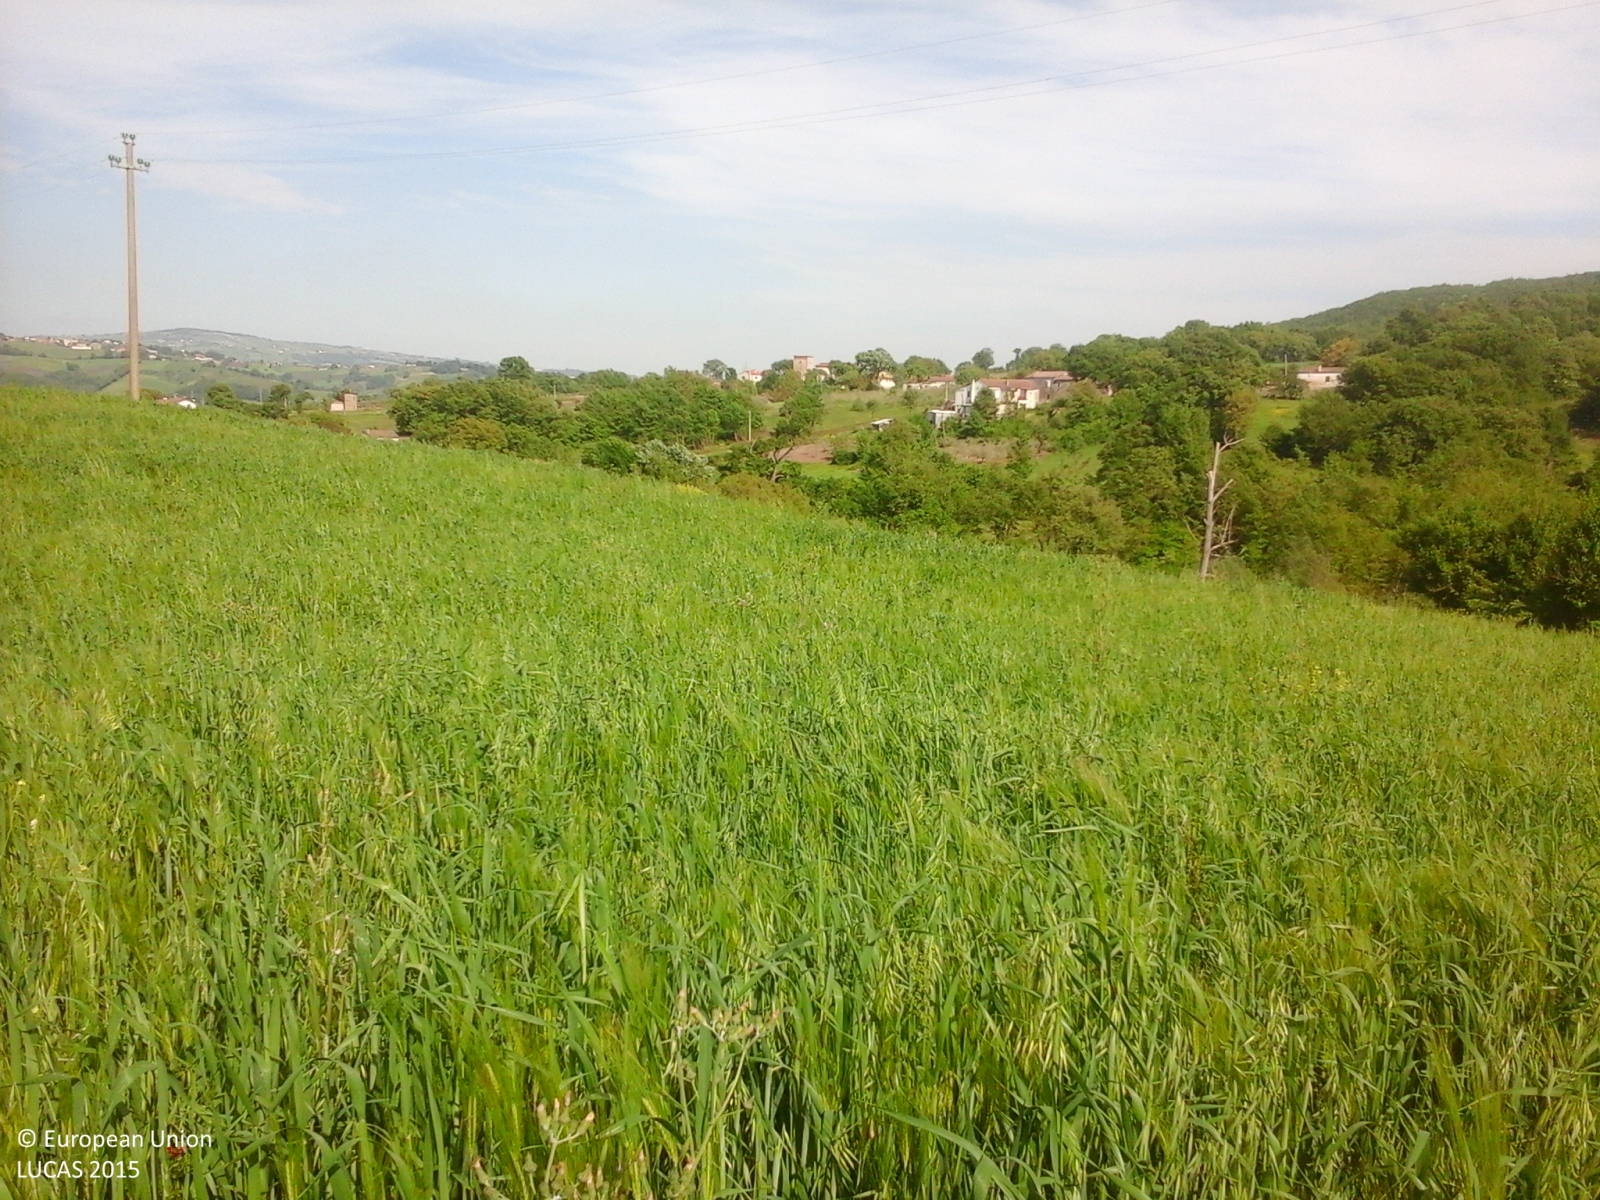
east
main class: Cropland
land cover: Barley
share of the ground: > 75 %
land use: Agriculture (excluding fallow land and kitchen gardens)
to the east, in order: Barley; Electric lines; Common wheat; Grassland with sparse tree/shrub cover; Abandoned hedges; Electric lines; Grassland with sparse tree/shrub cover; Ditches and canals; Temporary grasslands; Broadleaved woodland
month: May
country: IT
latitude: 41.3323
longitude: 14.7026
